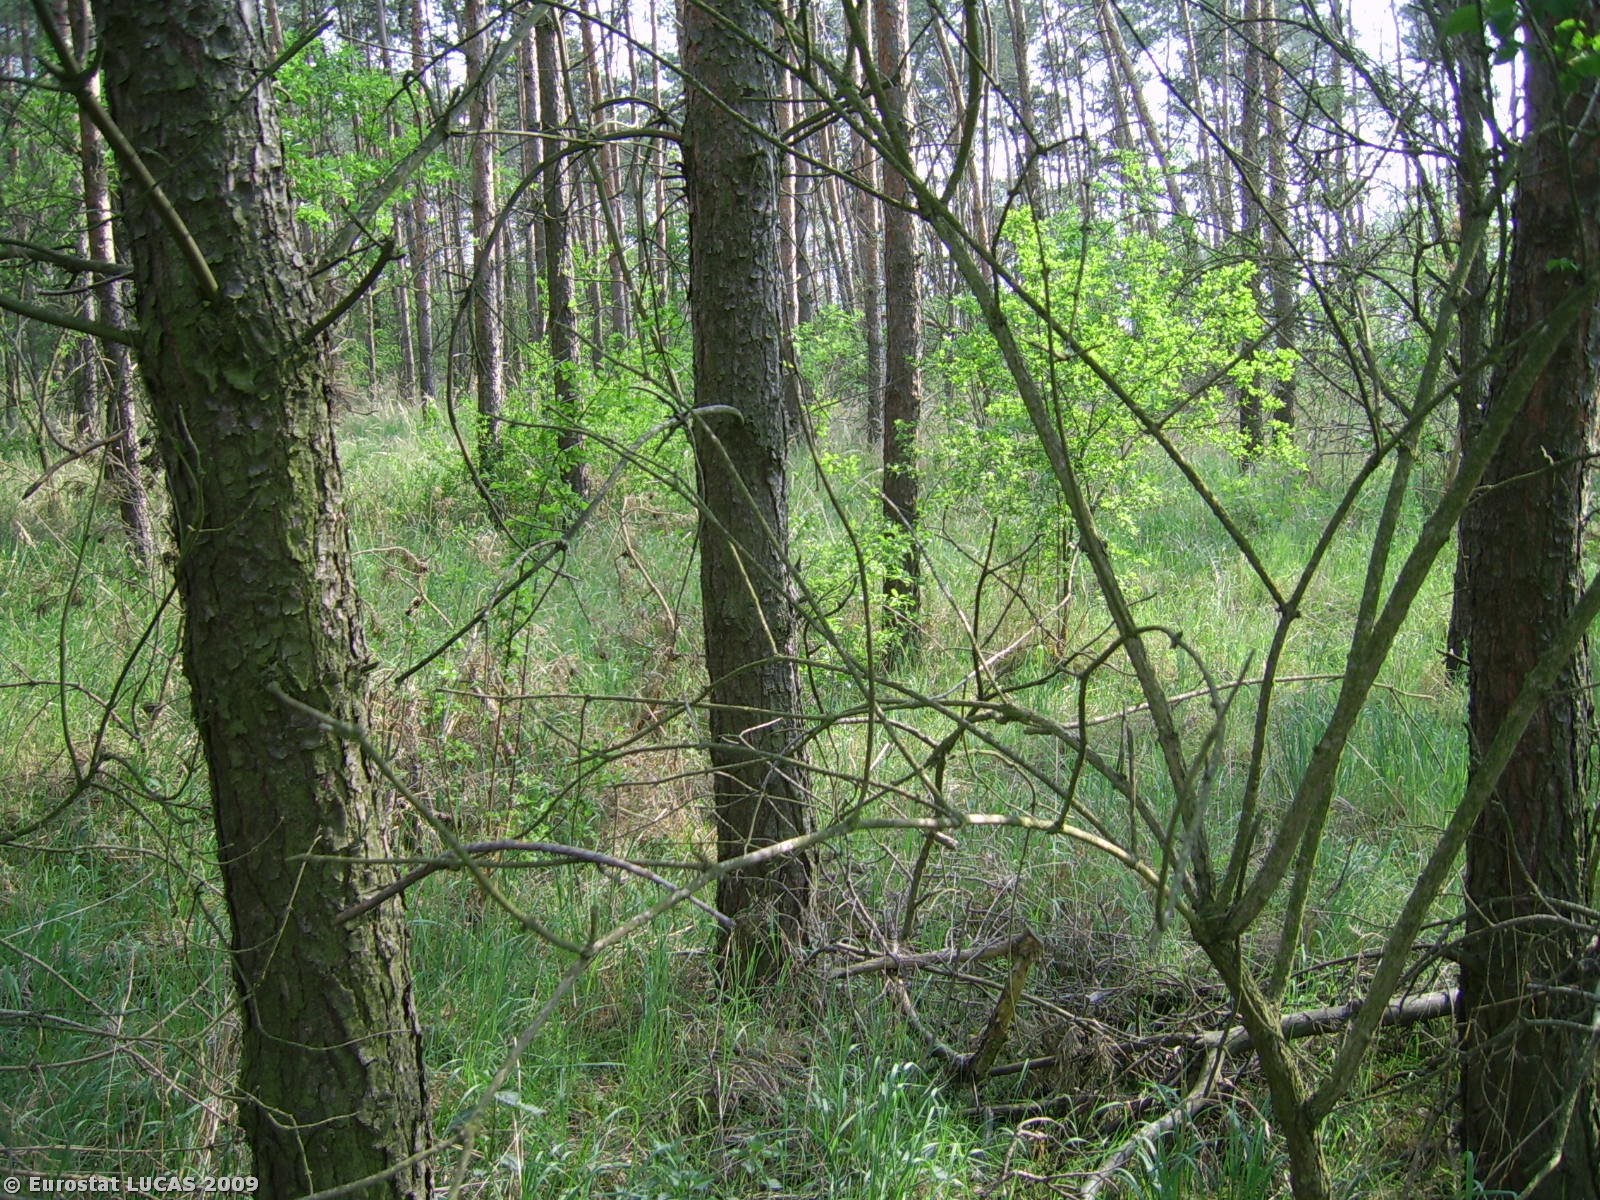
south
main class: Woodland
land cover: Coniferous woodland
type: hemiboreal forest and nemoral coniferous forest and mixed broadleaved-coniferous forest
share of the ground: > 75 %
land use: Forestry
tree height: > 5 m
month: April
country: PL
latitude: 51.9785
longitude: 16.8958
